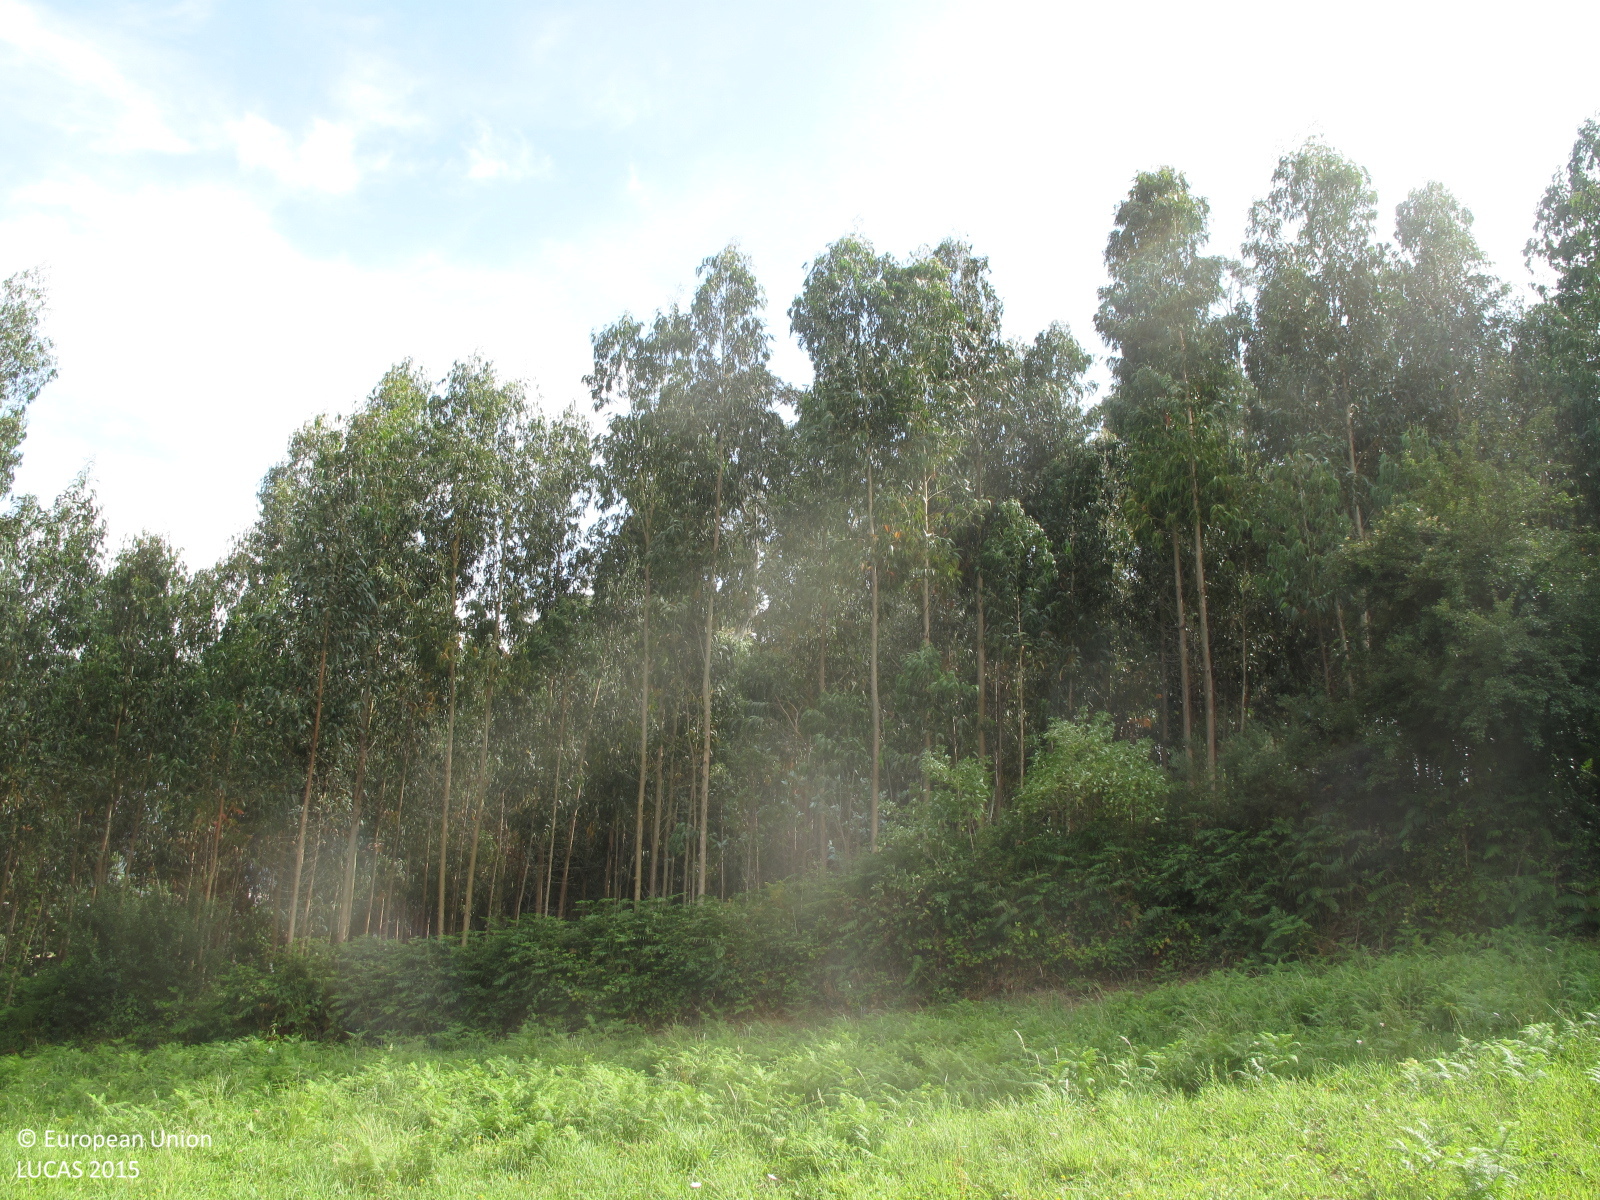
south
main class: Grassland
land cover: Grassland without tree/shrub cover
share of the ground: > 75 %
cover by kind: herbaceous plants 100 %
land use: Agriculture (excluding fallow land and kitchen gardens)
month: July
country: ES
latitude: 43.6744
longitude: -8.0471
